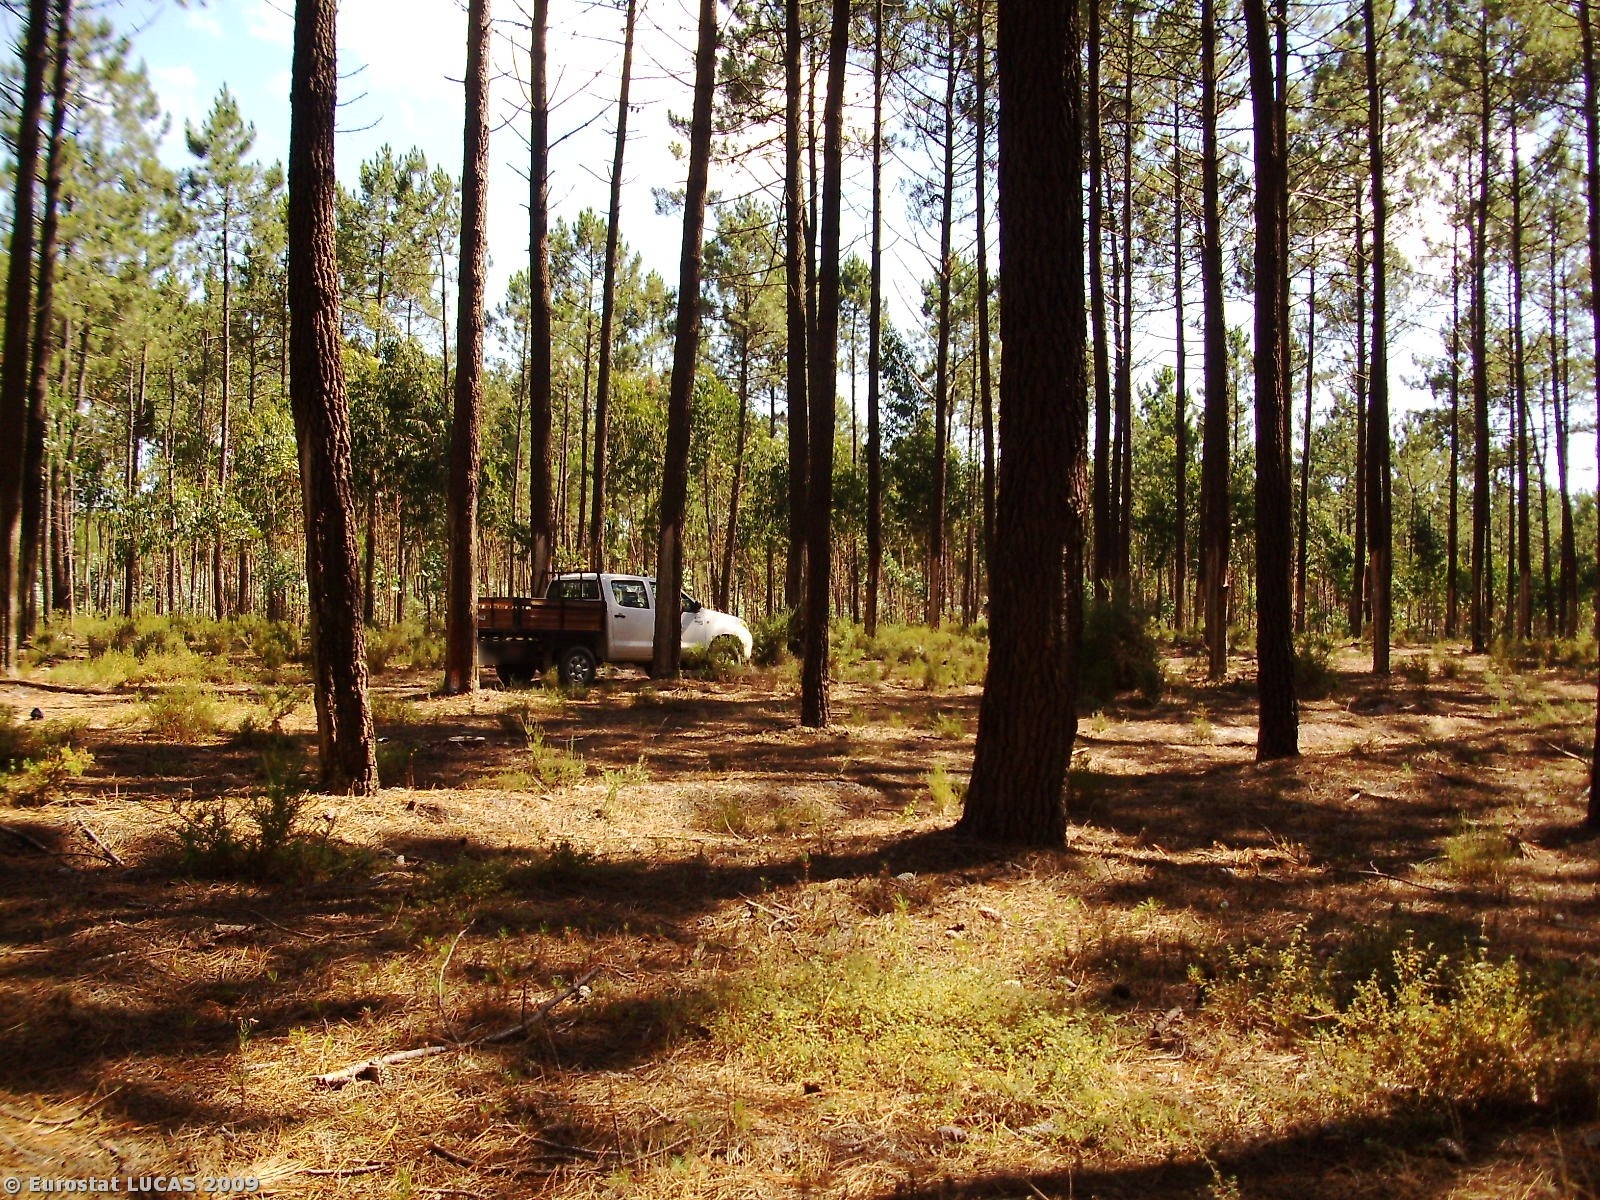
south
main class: Woodland
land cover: Coniferous woodland
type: coniferous forest of the mediterranean region
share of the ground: > 75 %
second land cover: Shrubland with sparse tree cover
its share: 10 - 25 %
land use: Forestry
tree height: > 5 m
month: July
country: PT
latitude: 39.7160
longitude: -8.9520
